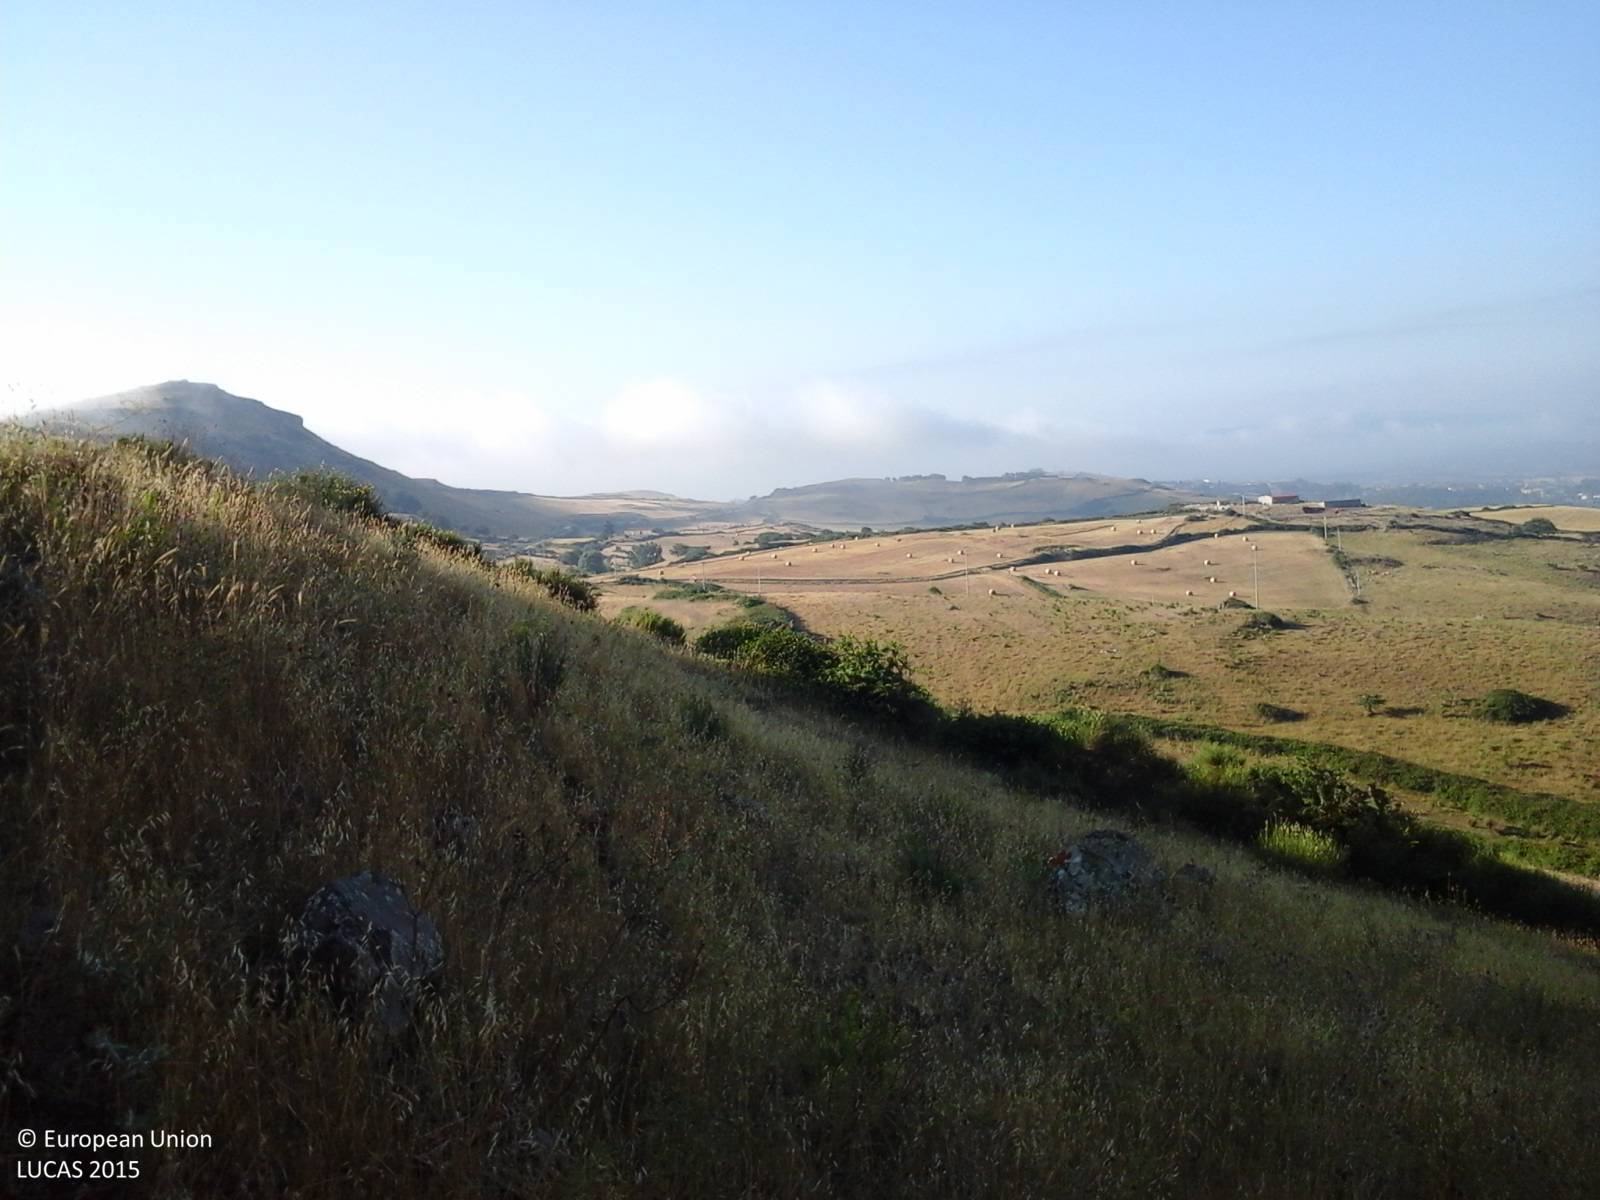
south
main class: Grassland
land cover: Grassland without tree/shrub cover
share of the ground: > 75 %
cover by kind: herbaceous plants 100 %
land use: Agriculture (excluding fallow land and kitchen gardens)
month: June
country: IT
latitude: 40.6936
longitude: 8.7399
